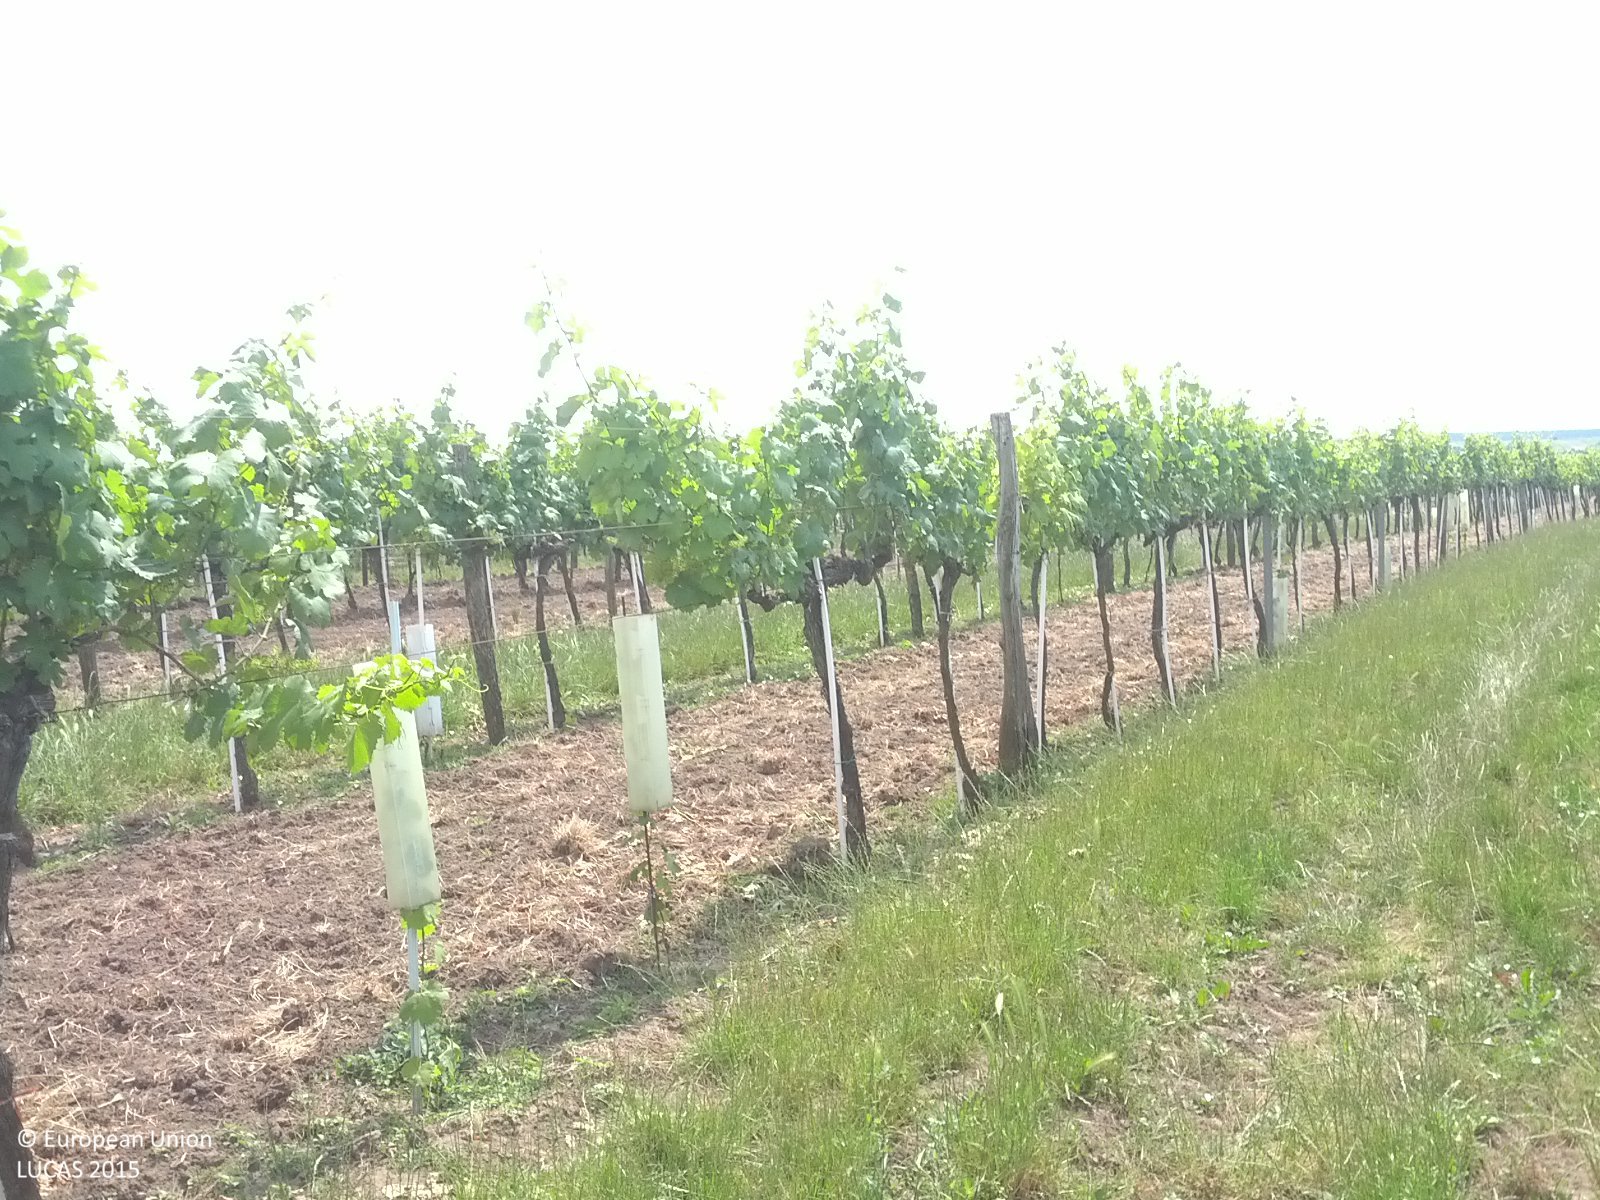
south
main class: Cropland
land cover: Vineyards
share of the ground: 25 - 50 %
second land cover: Grassland without tree/shrub cover
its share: 50 - 75 %
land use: Agriculture (excluding fallow land and kitchen gardens)
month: June
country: AT
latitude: 48.4562
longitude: 16.6459
